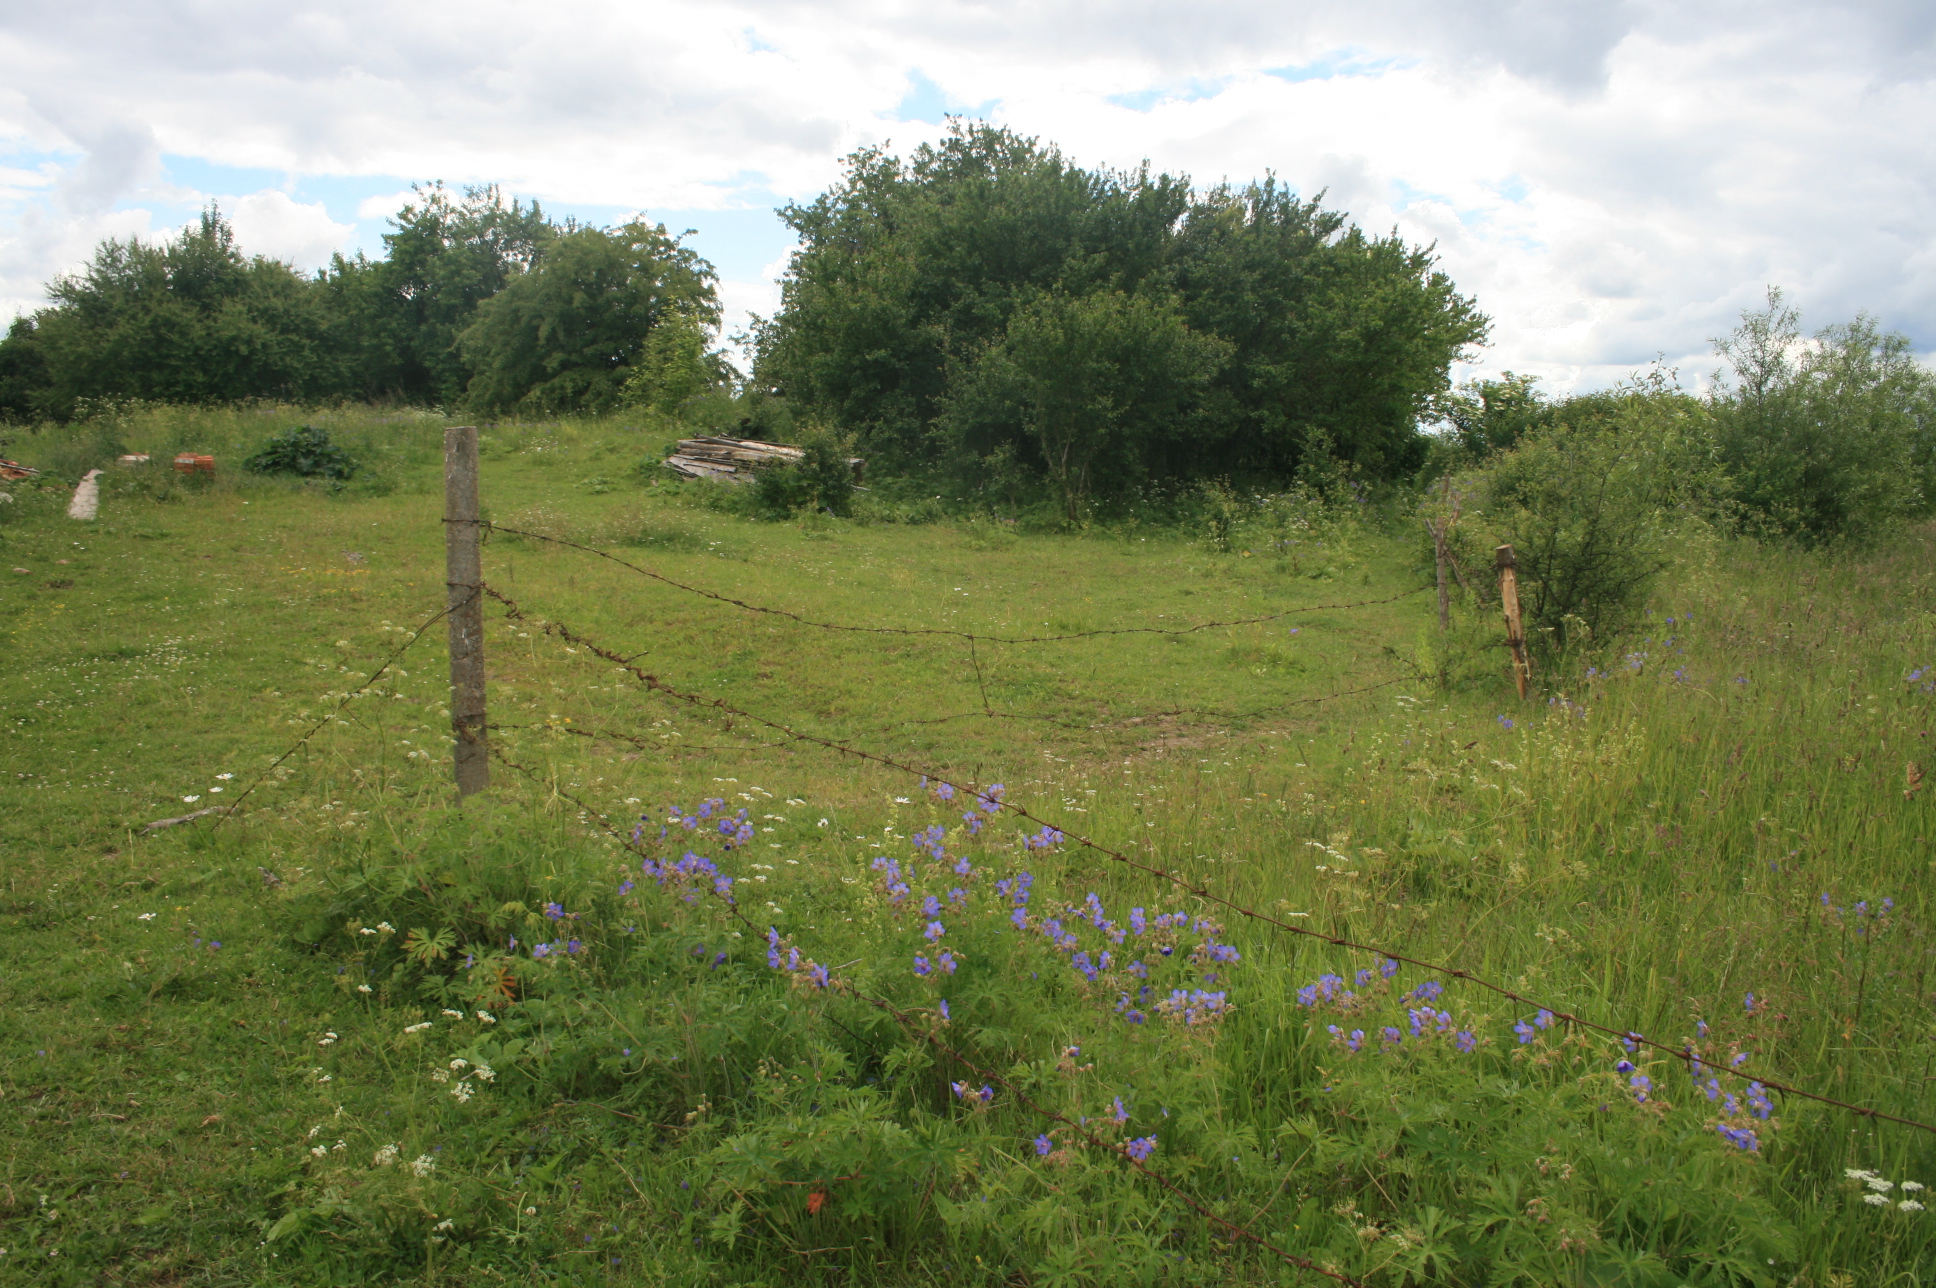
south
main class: Grassland
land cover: Spontaneously vegetated surfaces
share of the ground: > 75 %
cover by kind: herbaceous plants 100 %
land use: Agriculture (excluding fallow land and kitchen gardens)
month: June
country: LT
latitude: 55.1612
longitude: 22.0626
